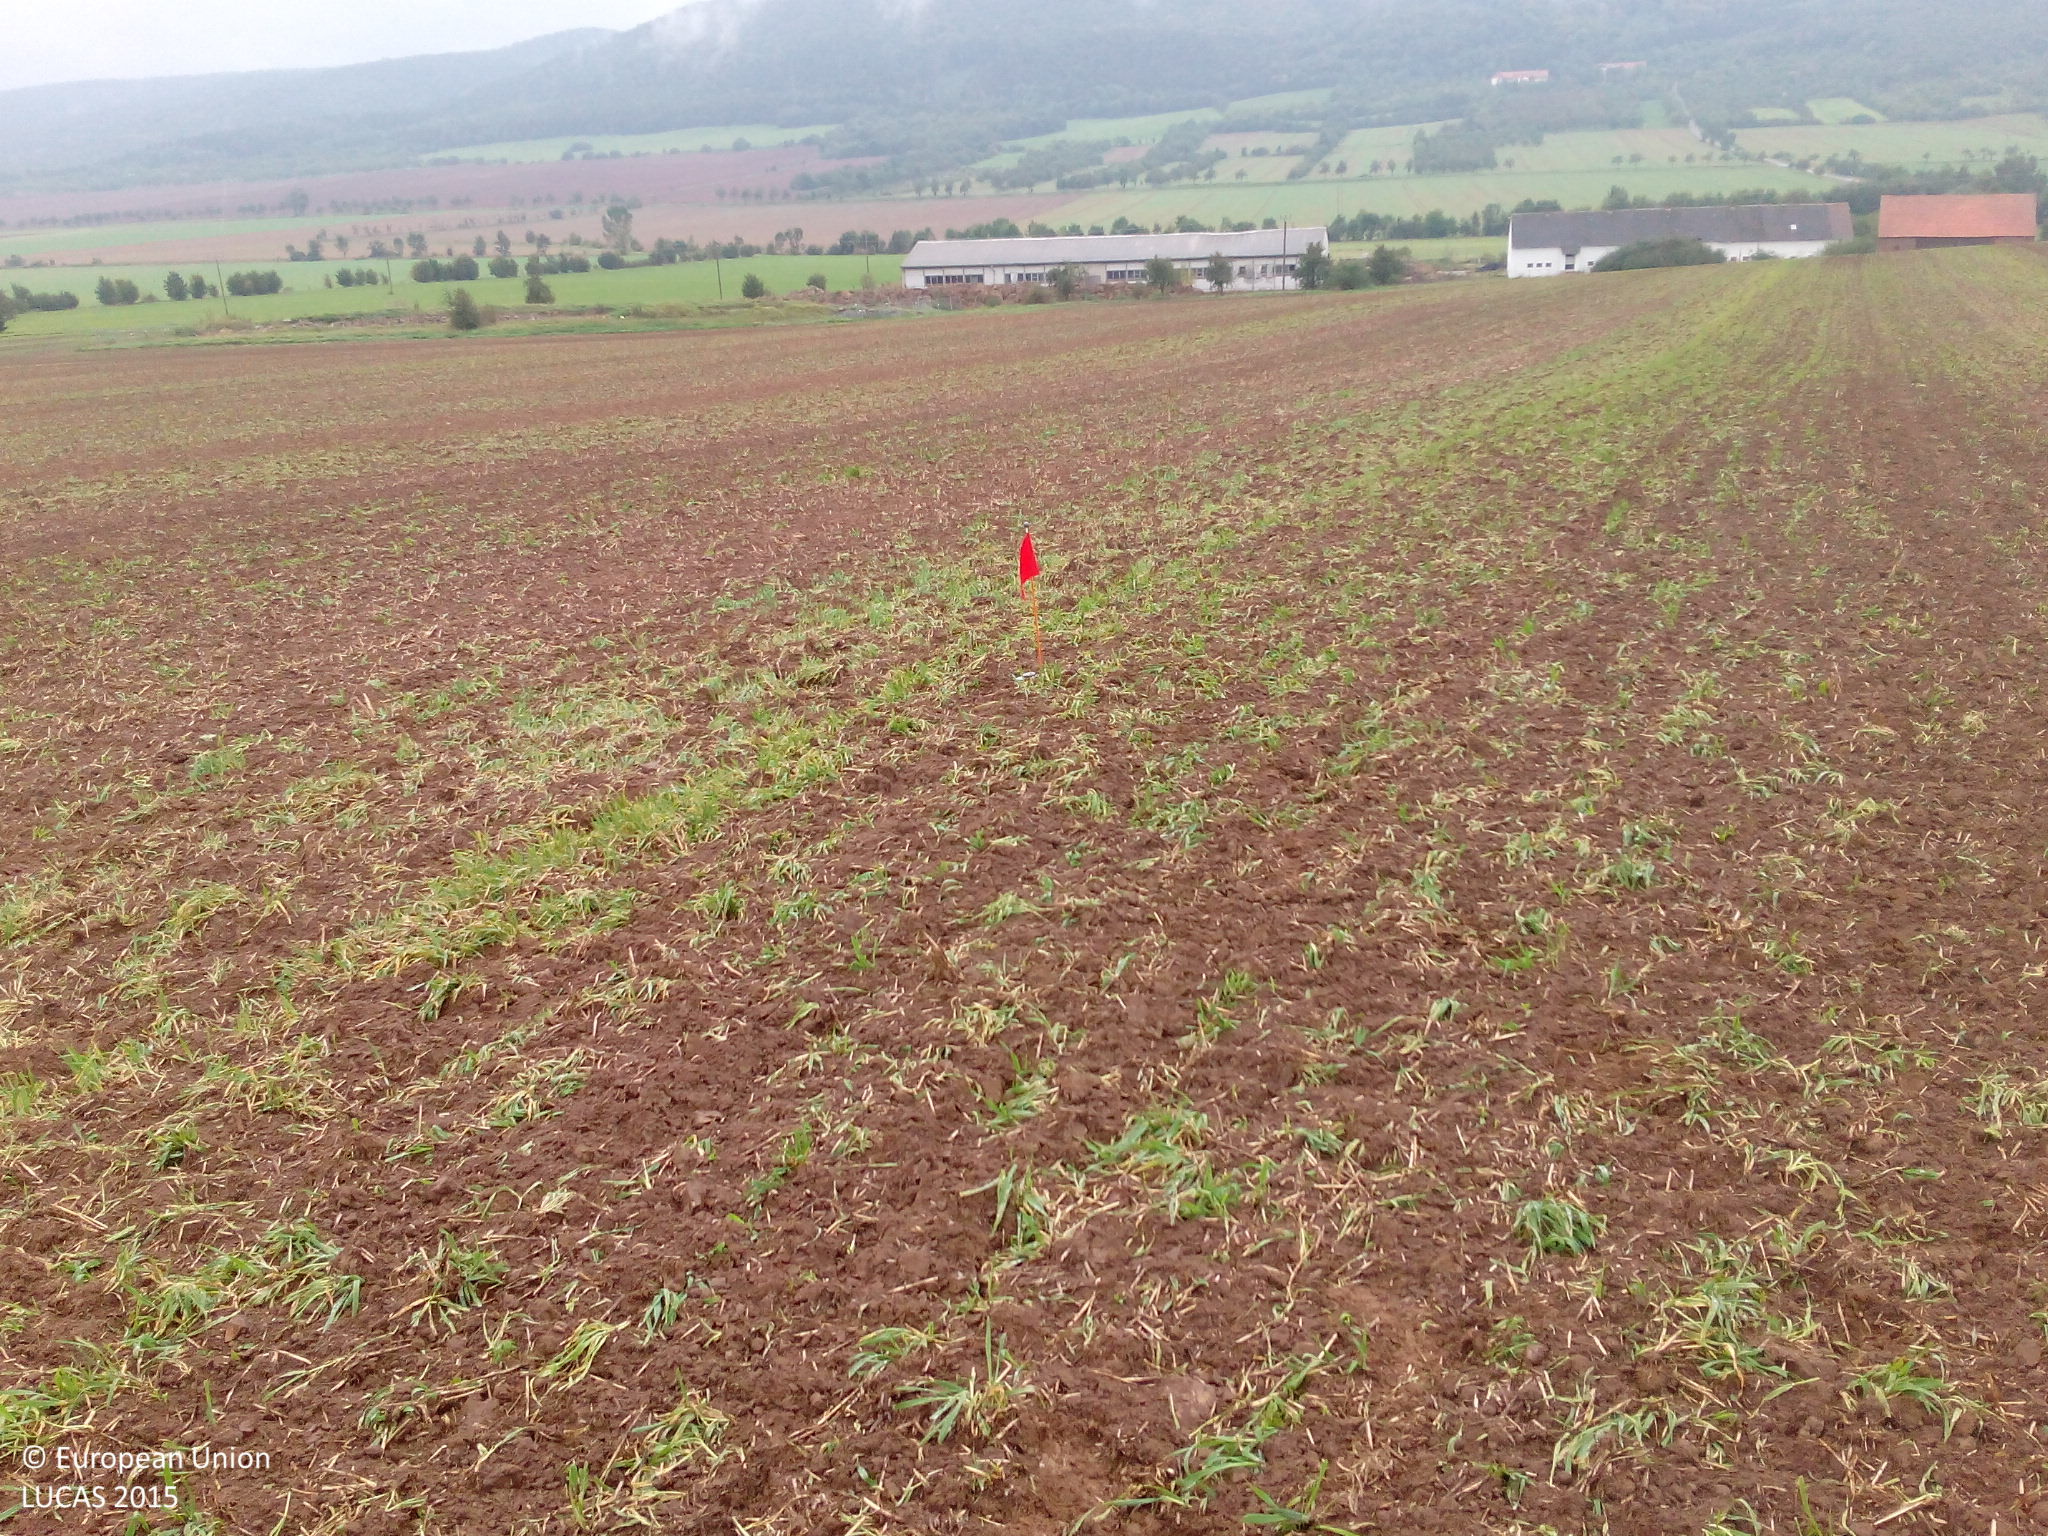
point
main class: Cropland
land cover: Barley
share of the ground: 10 - 25 %
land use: Agriculture (excluding fallow land and kitchen gardens)
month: September
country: DE
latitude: 51.4375
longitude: 11.1074
